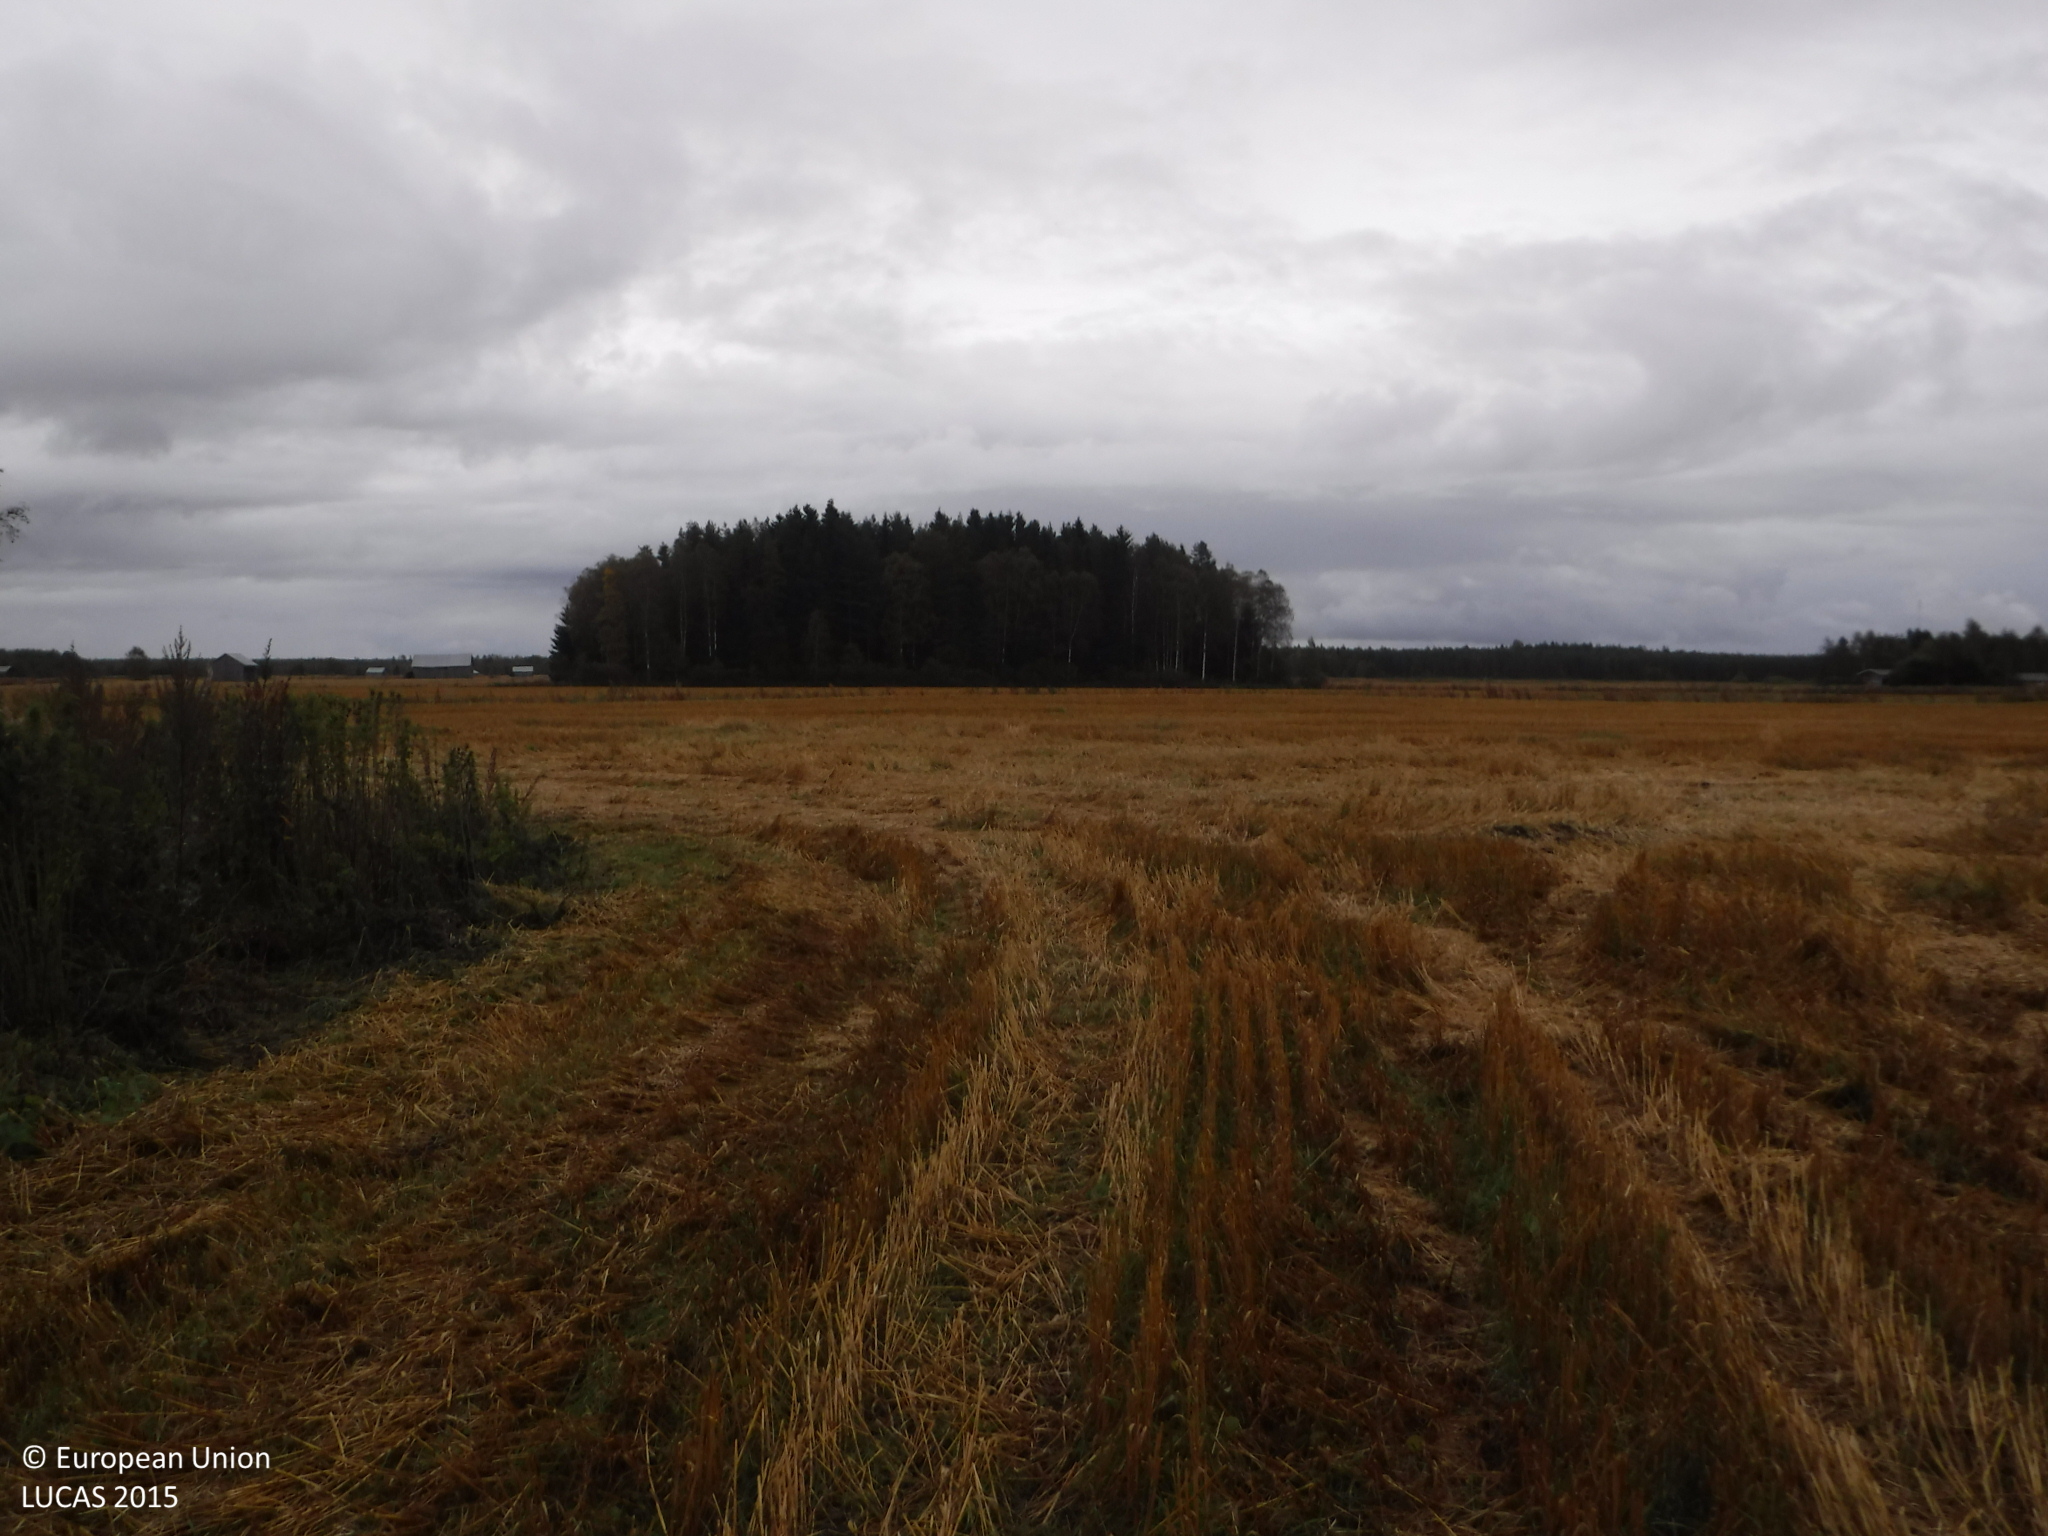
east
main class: Cropland
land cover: Oats
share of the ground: > 75 %
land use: Agriculture (excluding fallow land and kitchen gardens)
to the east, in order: Oats; Grassland without tree/shrub cover; Inland fresh running water; Grassland without tree/shrub cover; Oats; Grass margins; Ditches and canals; Grass margins; Oats; Grass margins; Ditches and canals; Groves; Other mixed woodland
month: September
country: FI
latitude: 62.0289
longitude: 22.3463
